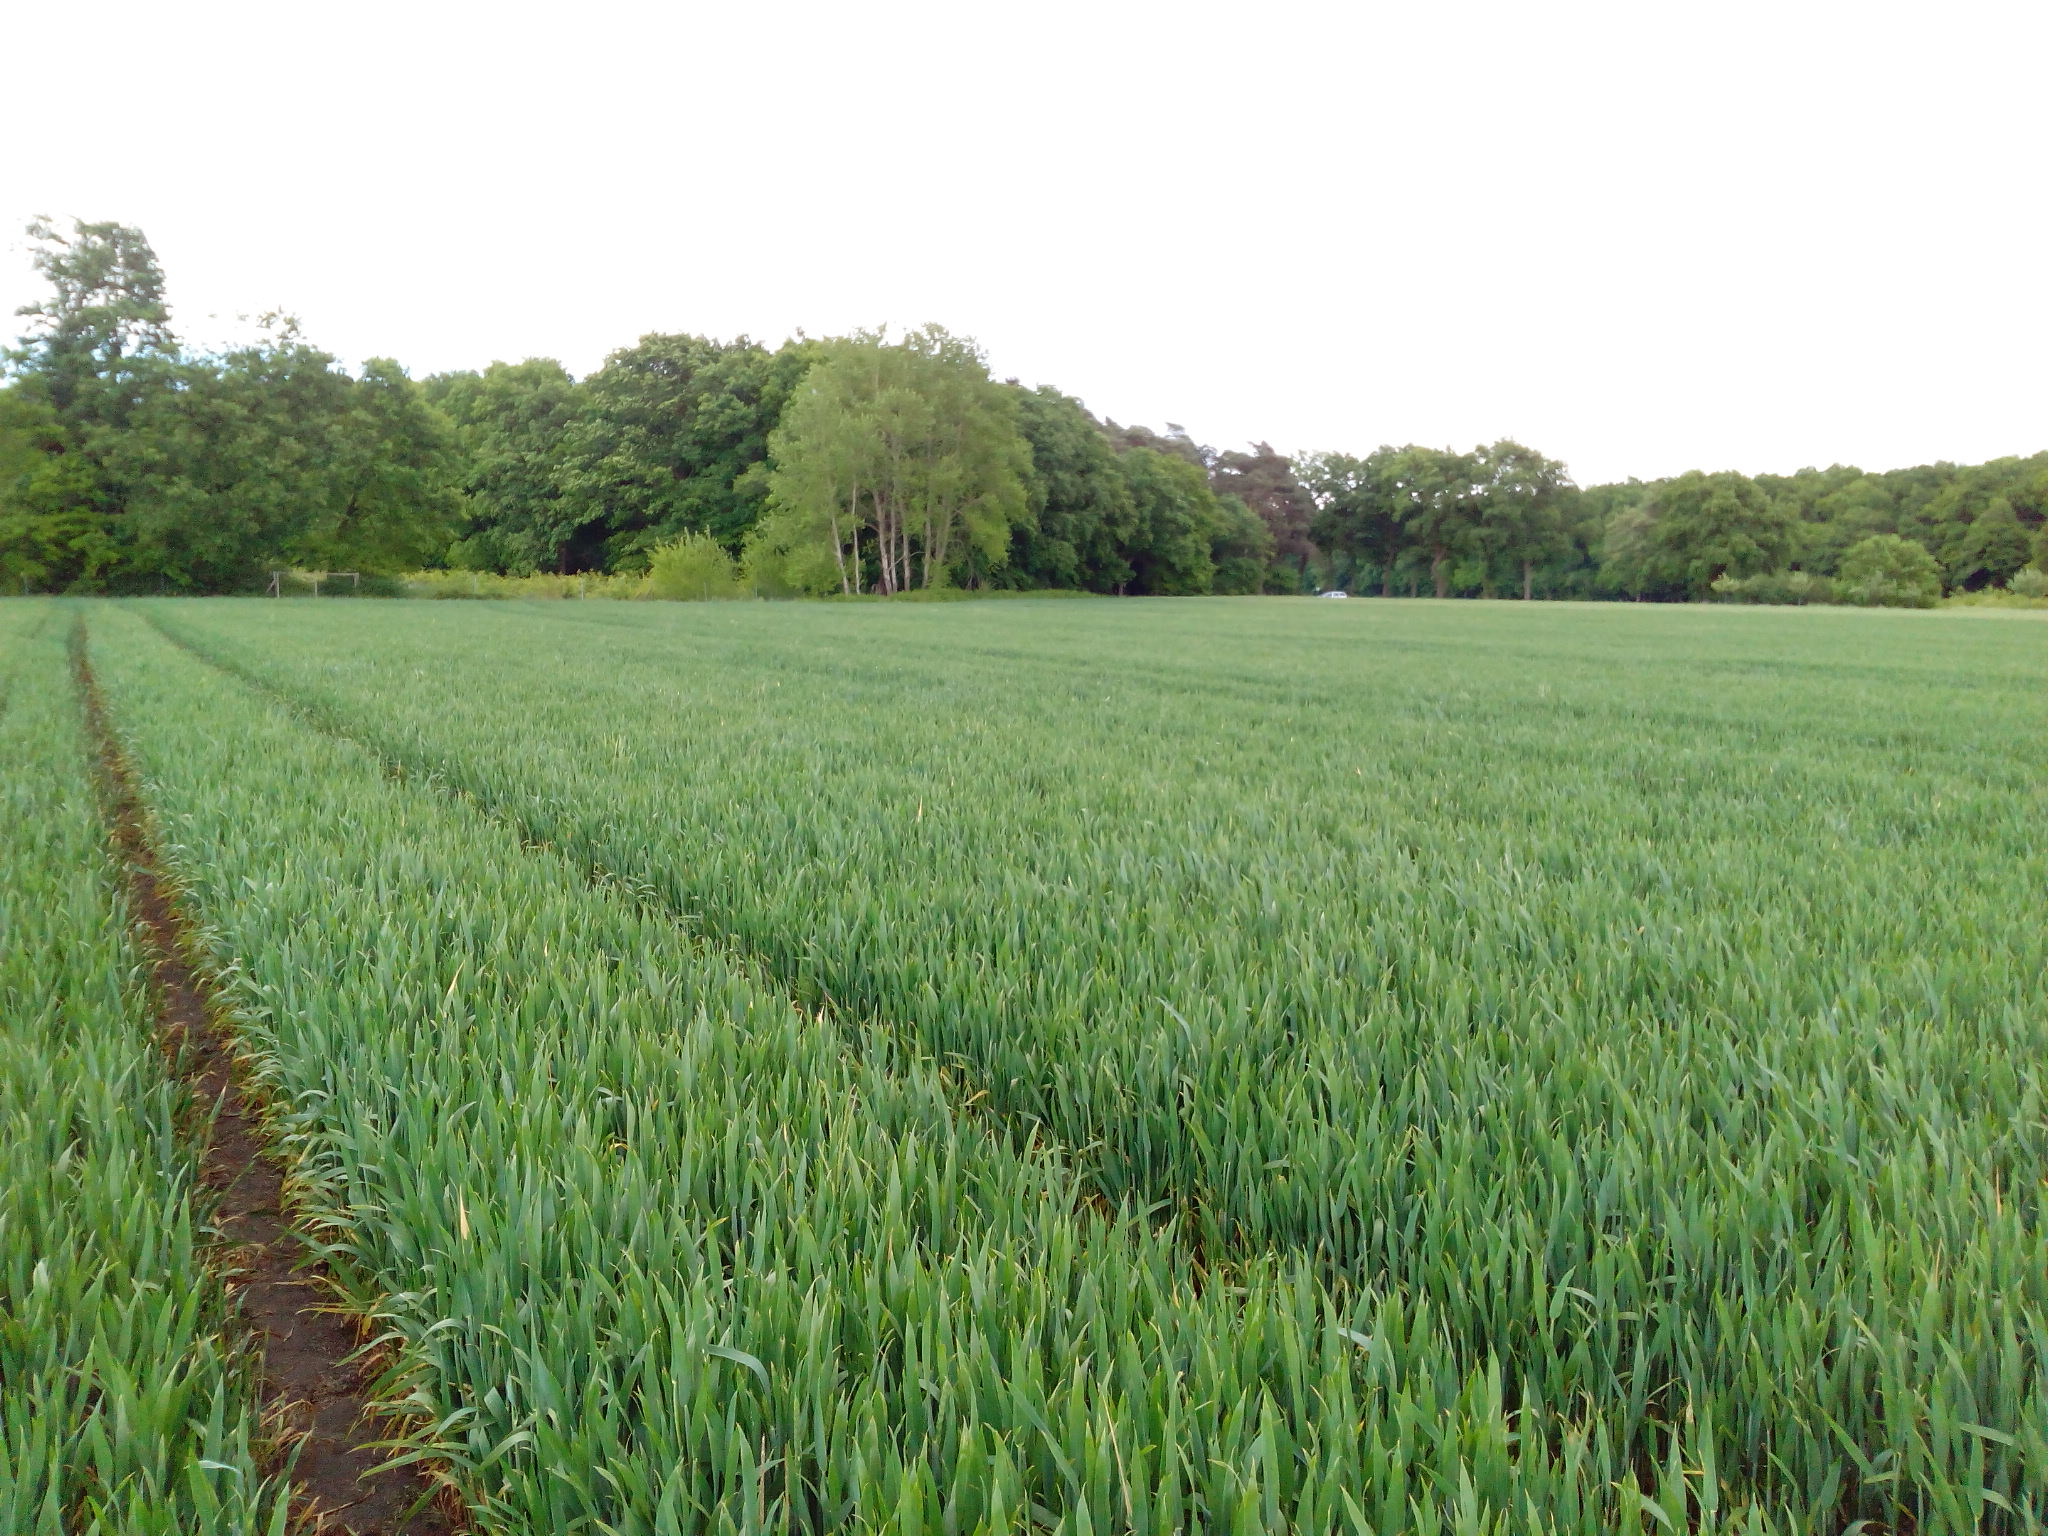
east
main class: Cropland
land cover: Common wheat
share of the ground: > 75 %
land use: Agriculture (excluding fallow land and kitchen gardens)
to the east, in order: Common wheat; Broadleaved woodland; Grassland without tree/shrub cover; Pine dominated mixed woodland; Spruce dominated coniferous woodland
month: May
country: DE
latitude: 52.6988
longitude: 9.2752
